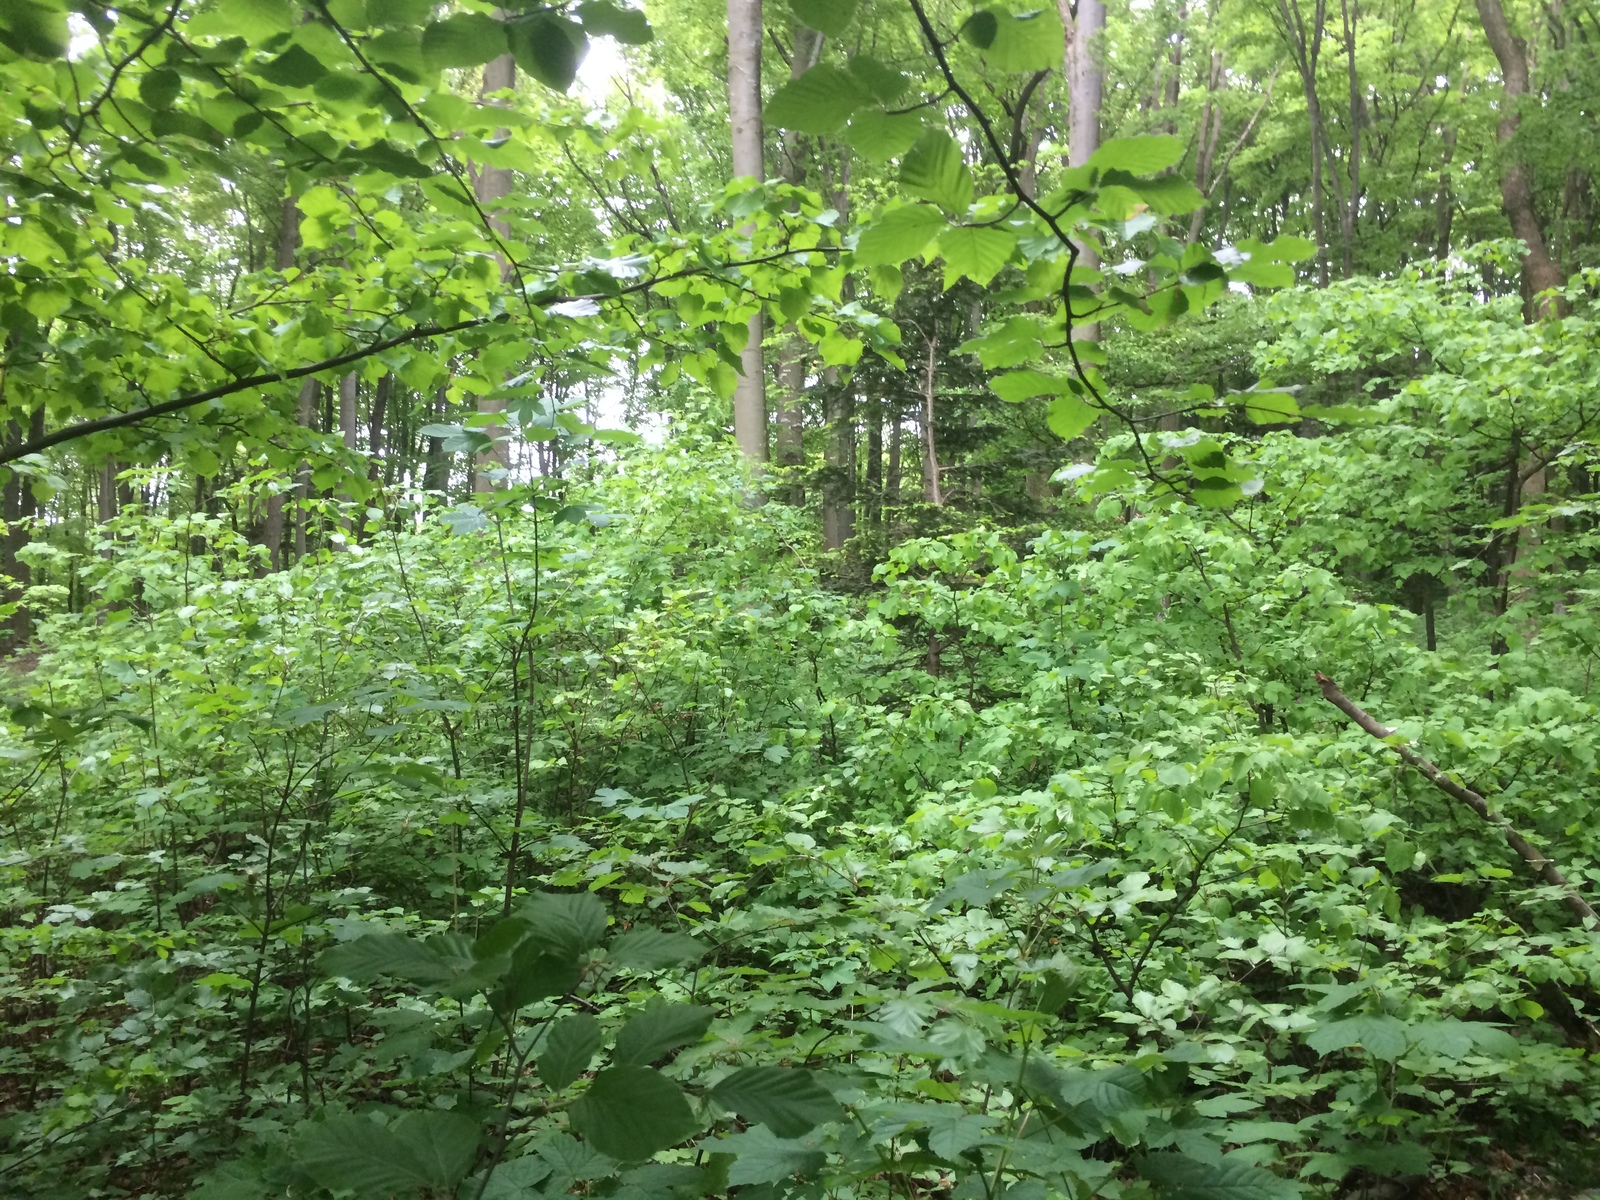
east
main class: Woodland
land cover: Broadleaved woodland
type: beech forest
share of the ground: > 75 %
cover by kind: broadleaved forest trees 100 %
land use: Forestry
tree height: > 5 m
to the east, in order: Broadleaved woodland; Tracks; Broadleaved woodland; Pine dominated mixed woodland
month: May
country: AT
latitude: 48.0302
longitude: 16.2131
